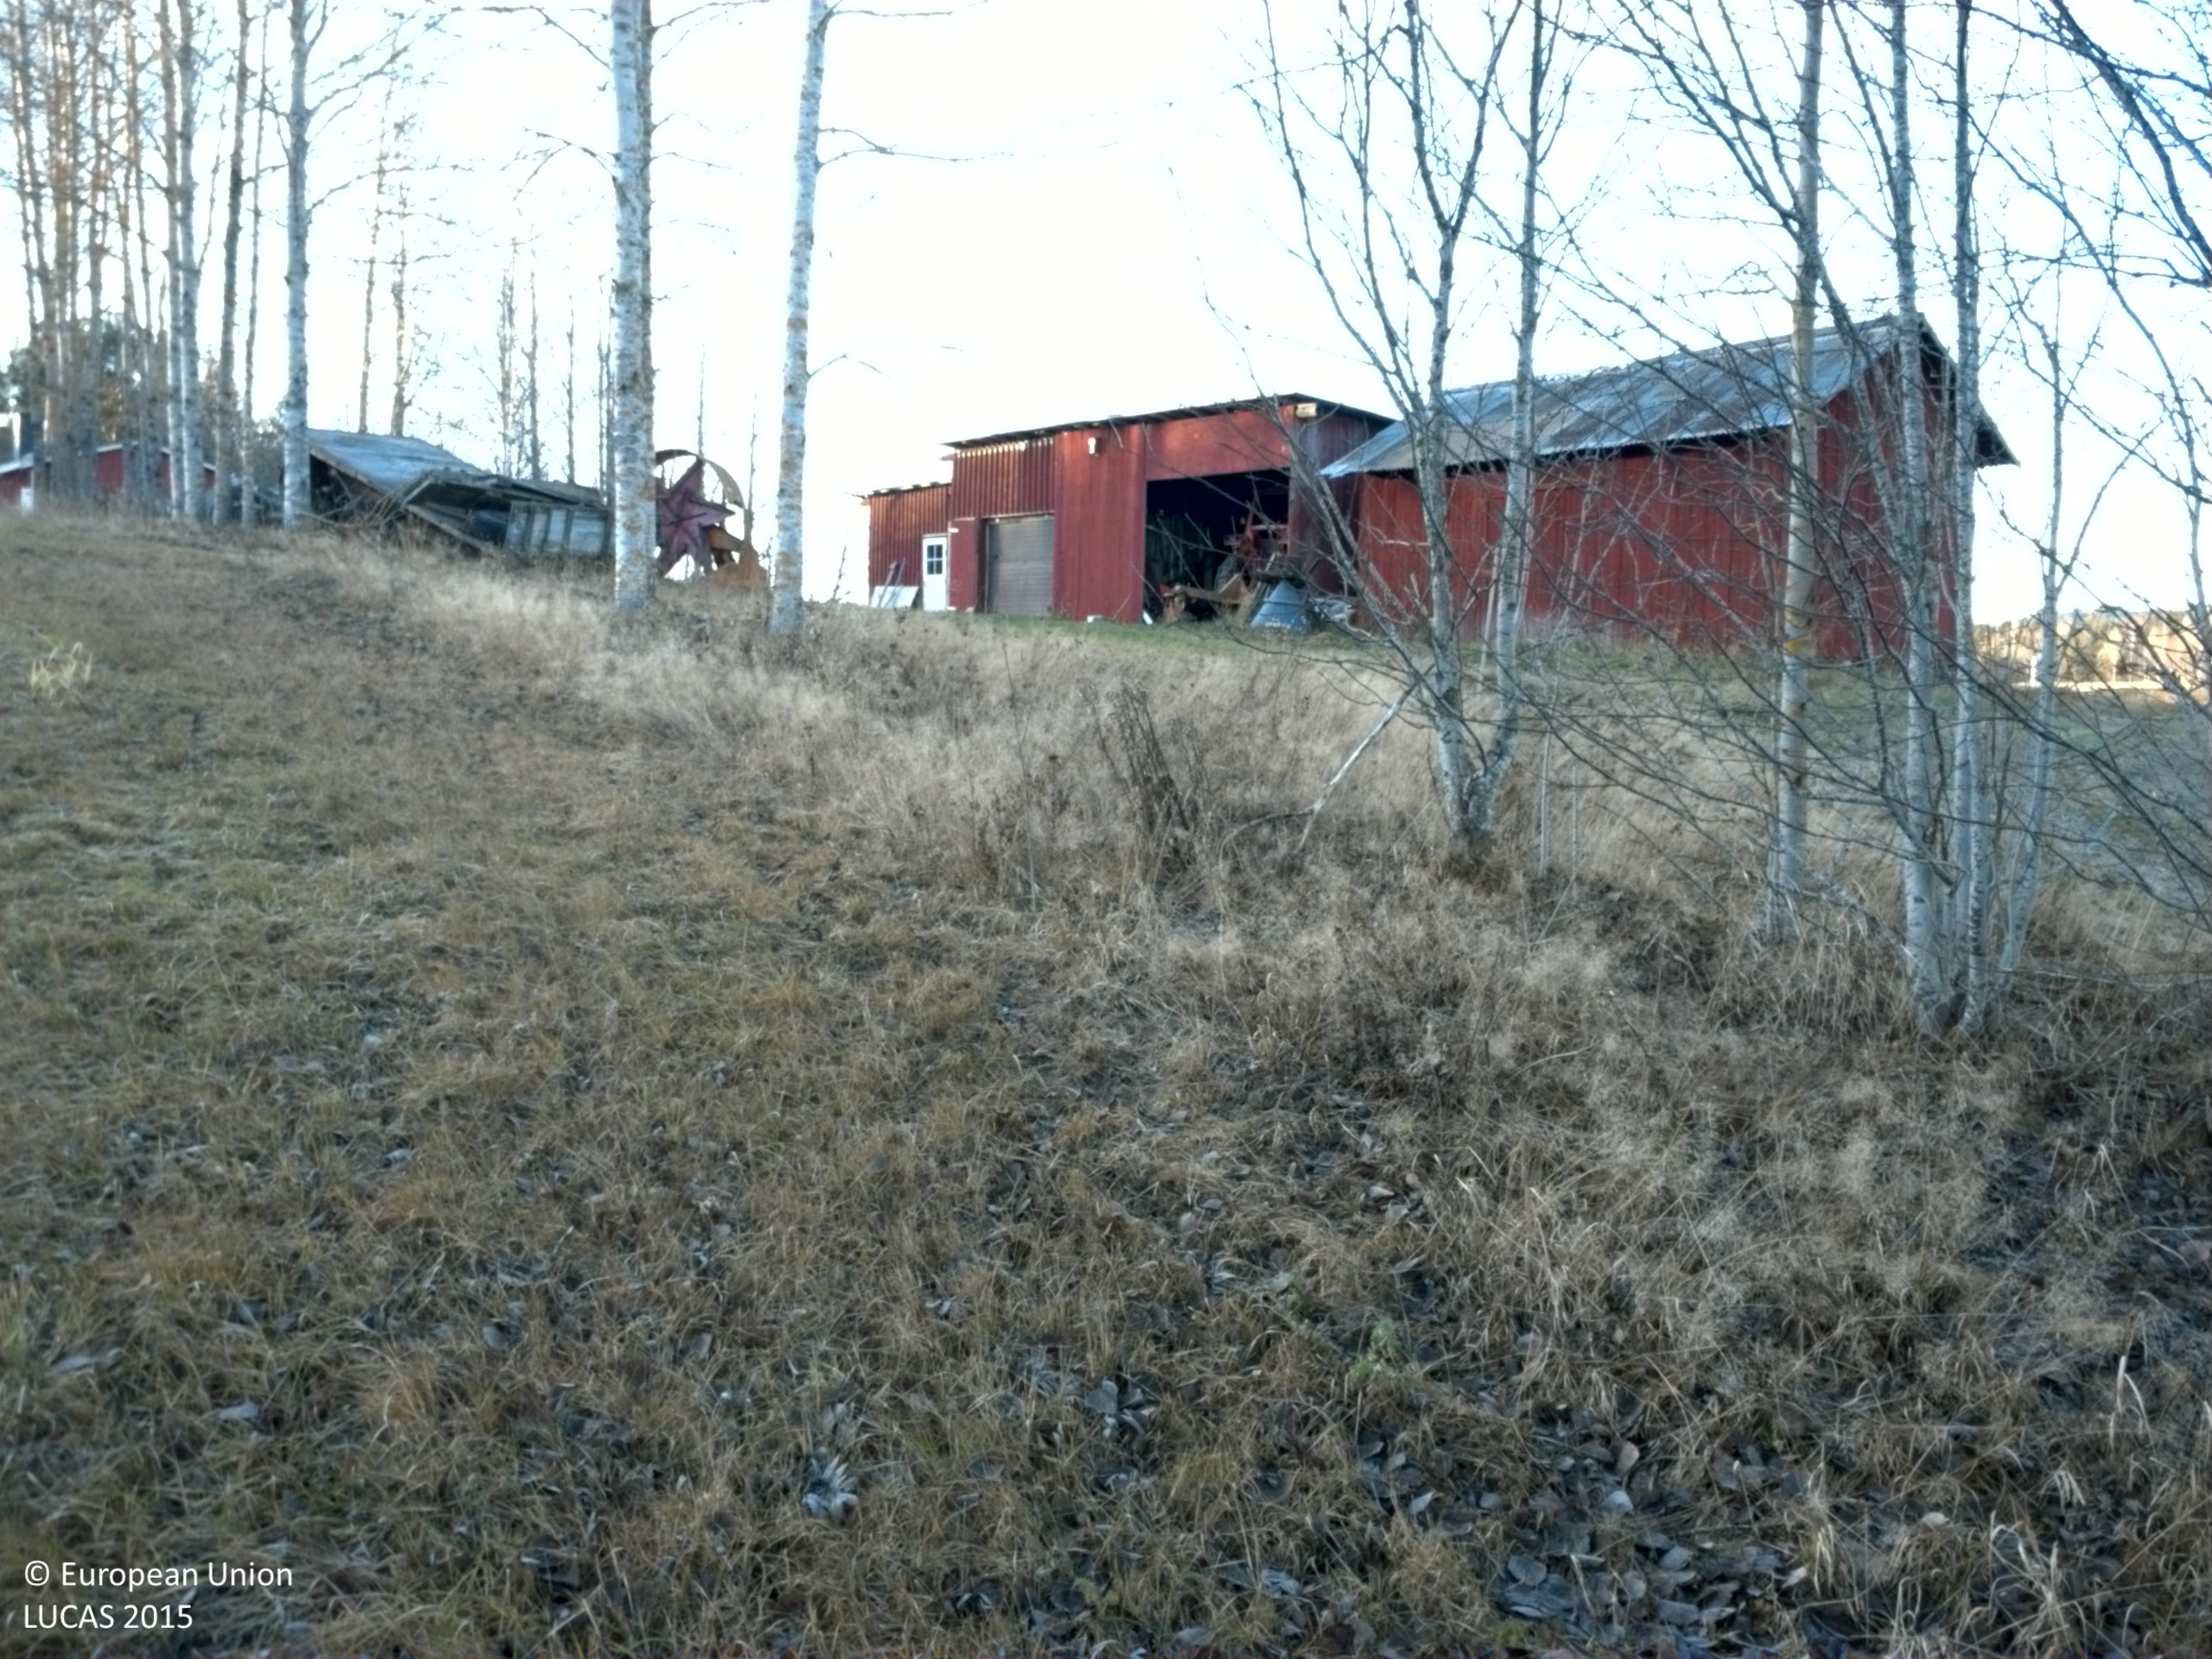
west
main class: Cropland
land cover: Temporary grasslands
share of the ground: > 75 %
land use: Agriculture (excluding fallow land and kitchen gardens)
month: November
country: SE
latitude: 61.2699
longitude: 16.6805
